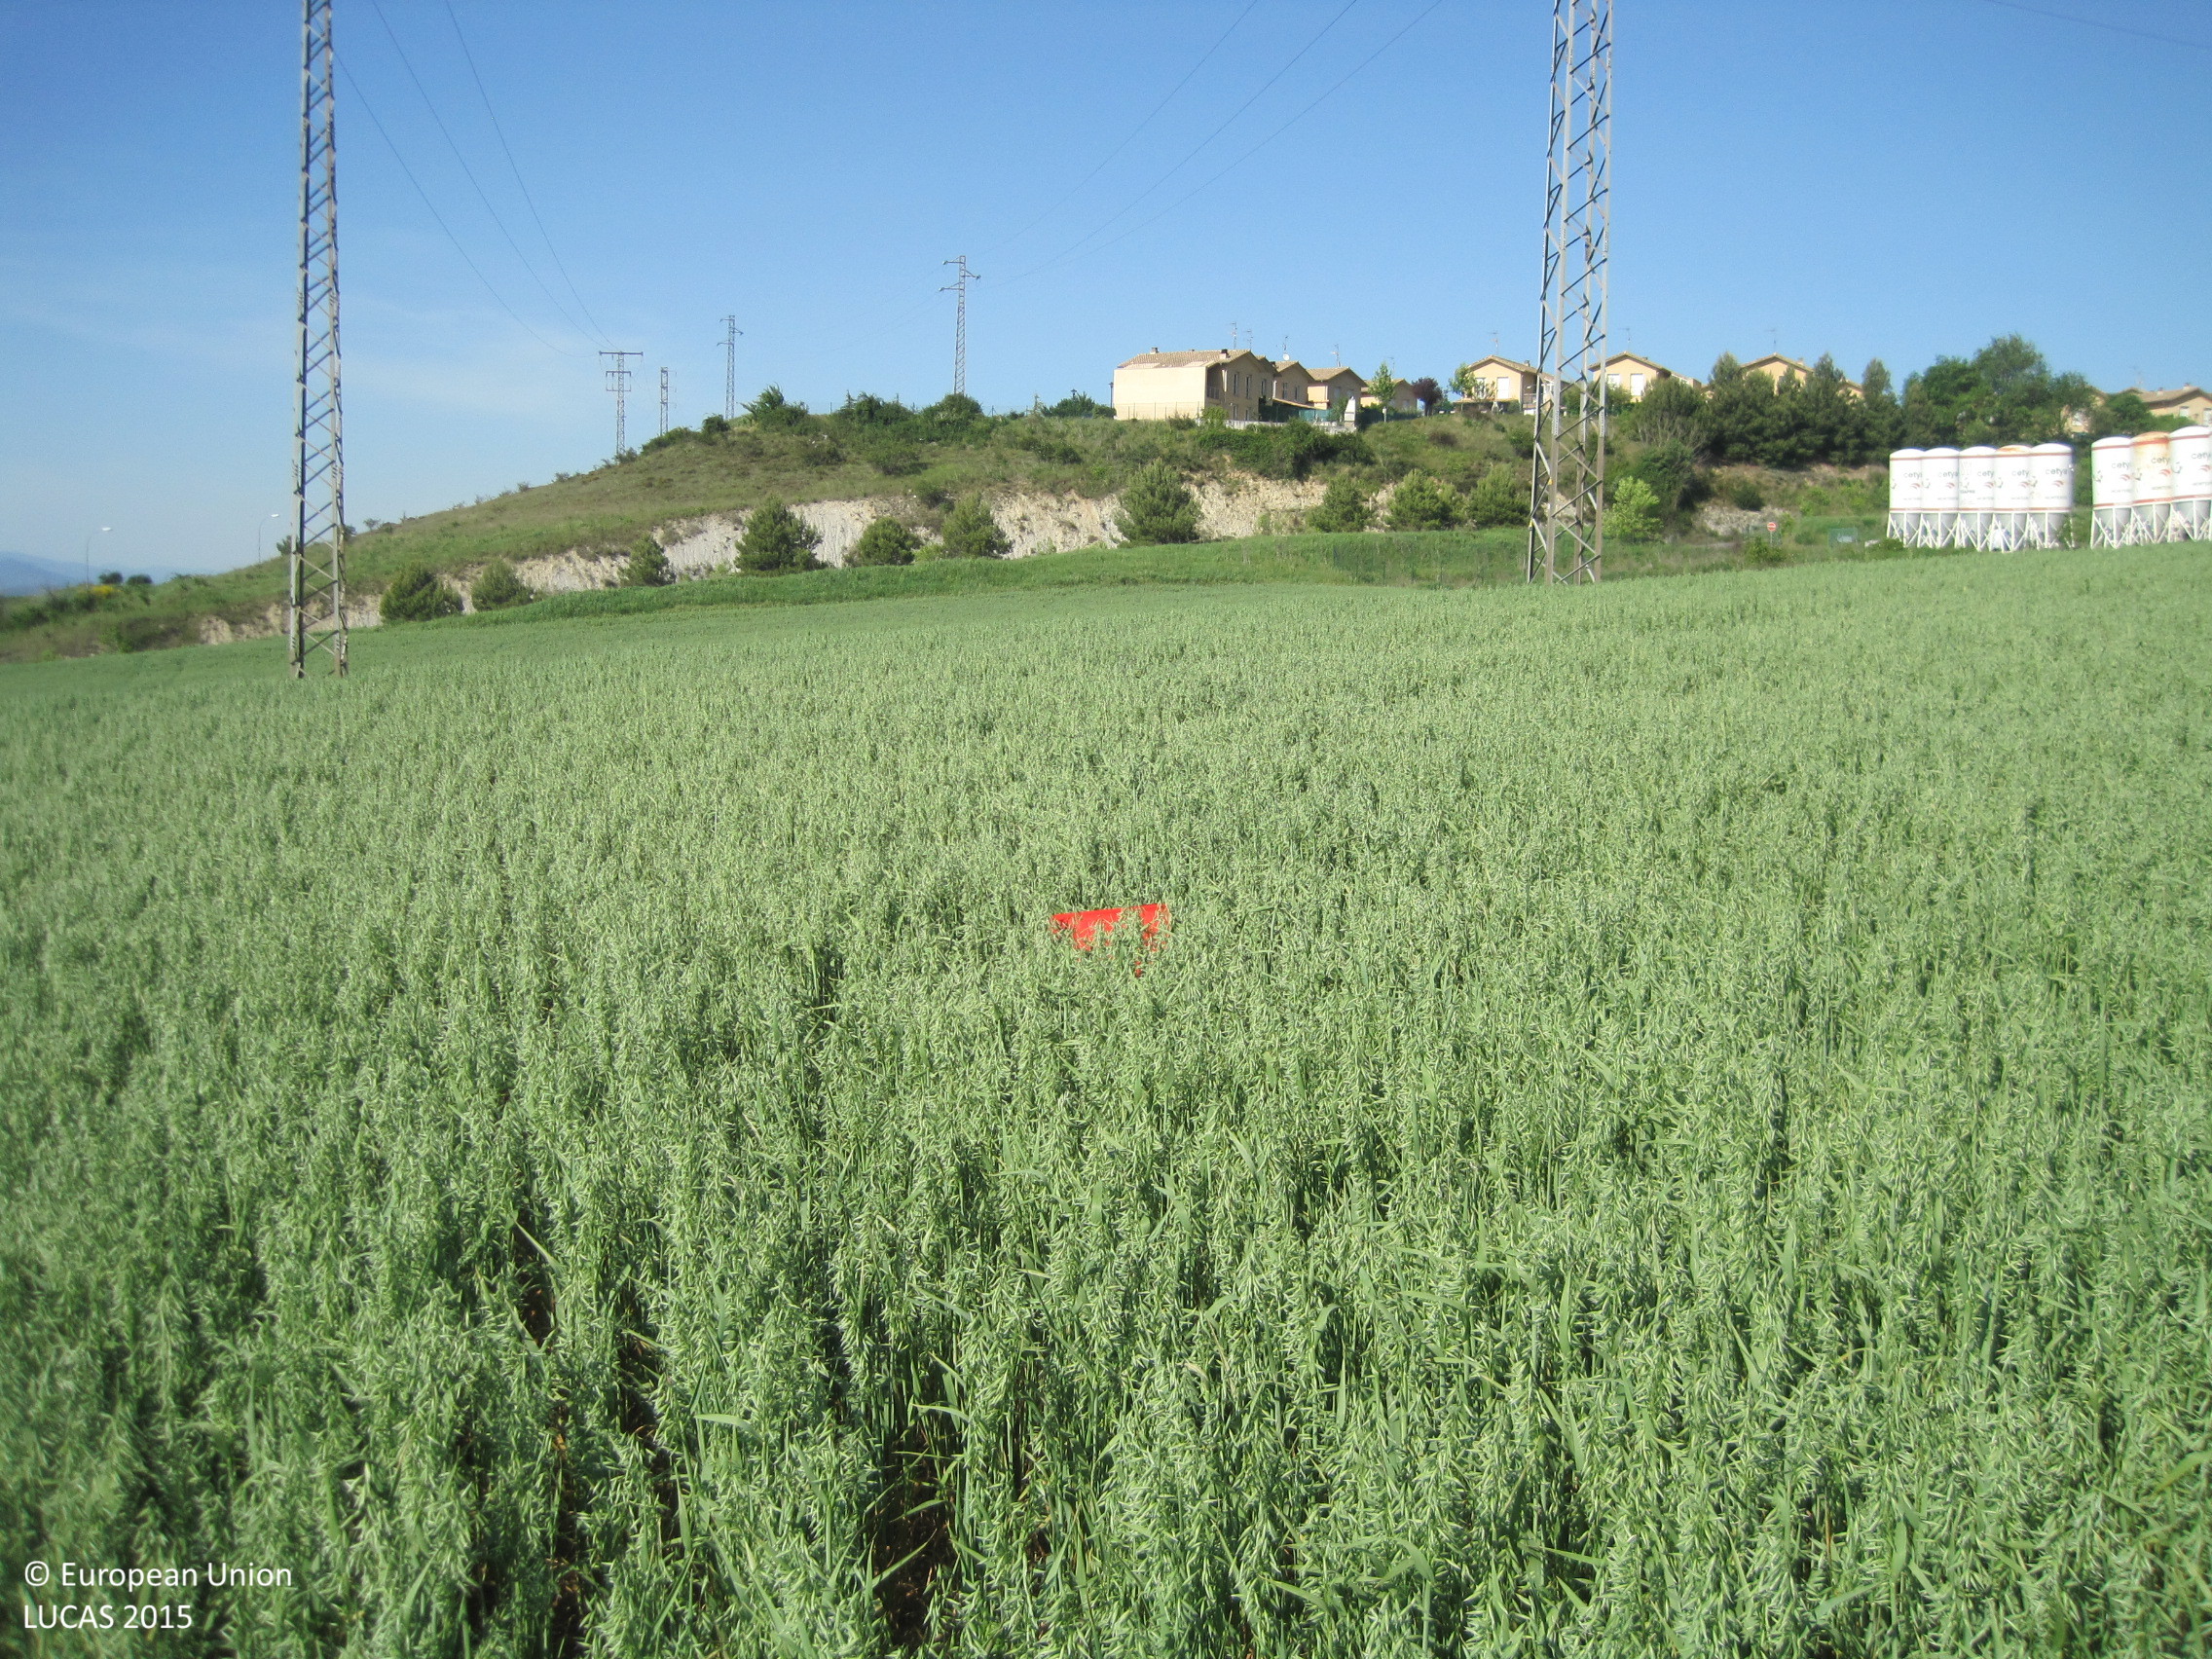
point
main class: Cropland
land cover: Oats
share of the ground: > 75 %
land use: Agriculture (excluding fallow land and kitchen gardens)
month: May
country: ES
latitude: 42.6906
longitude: -1.6456
